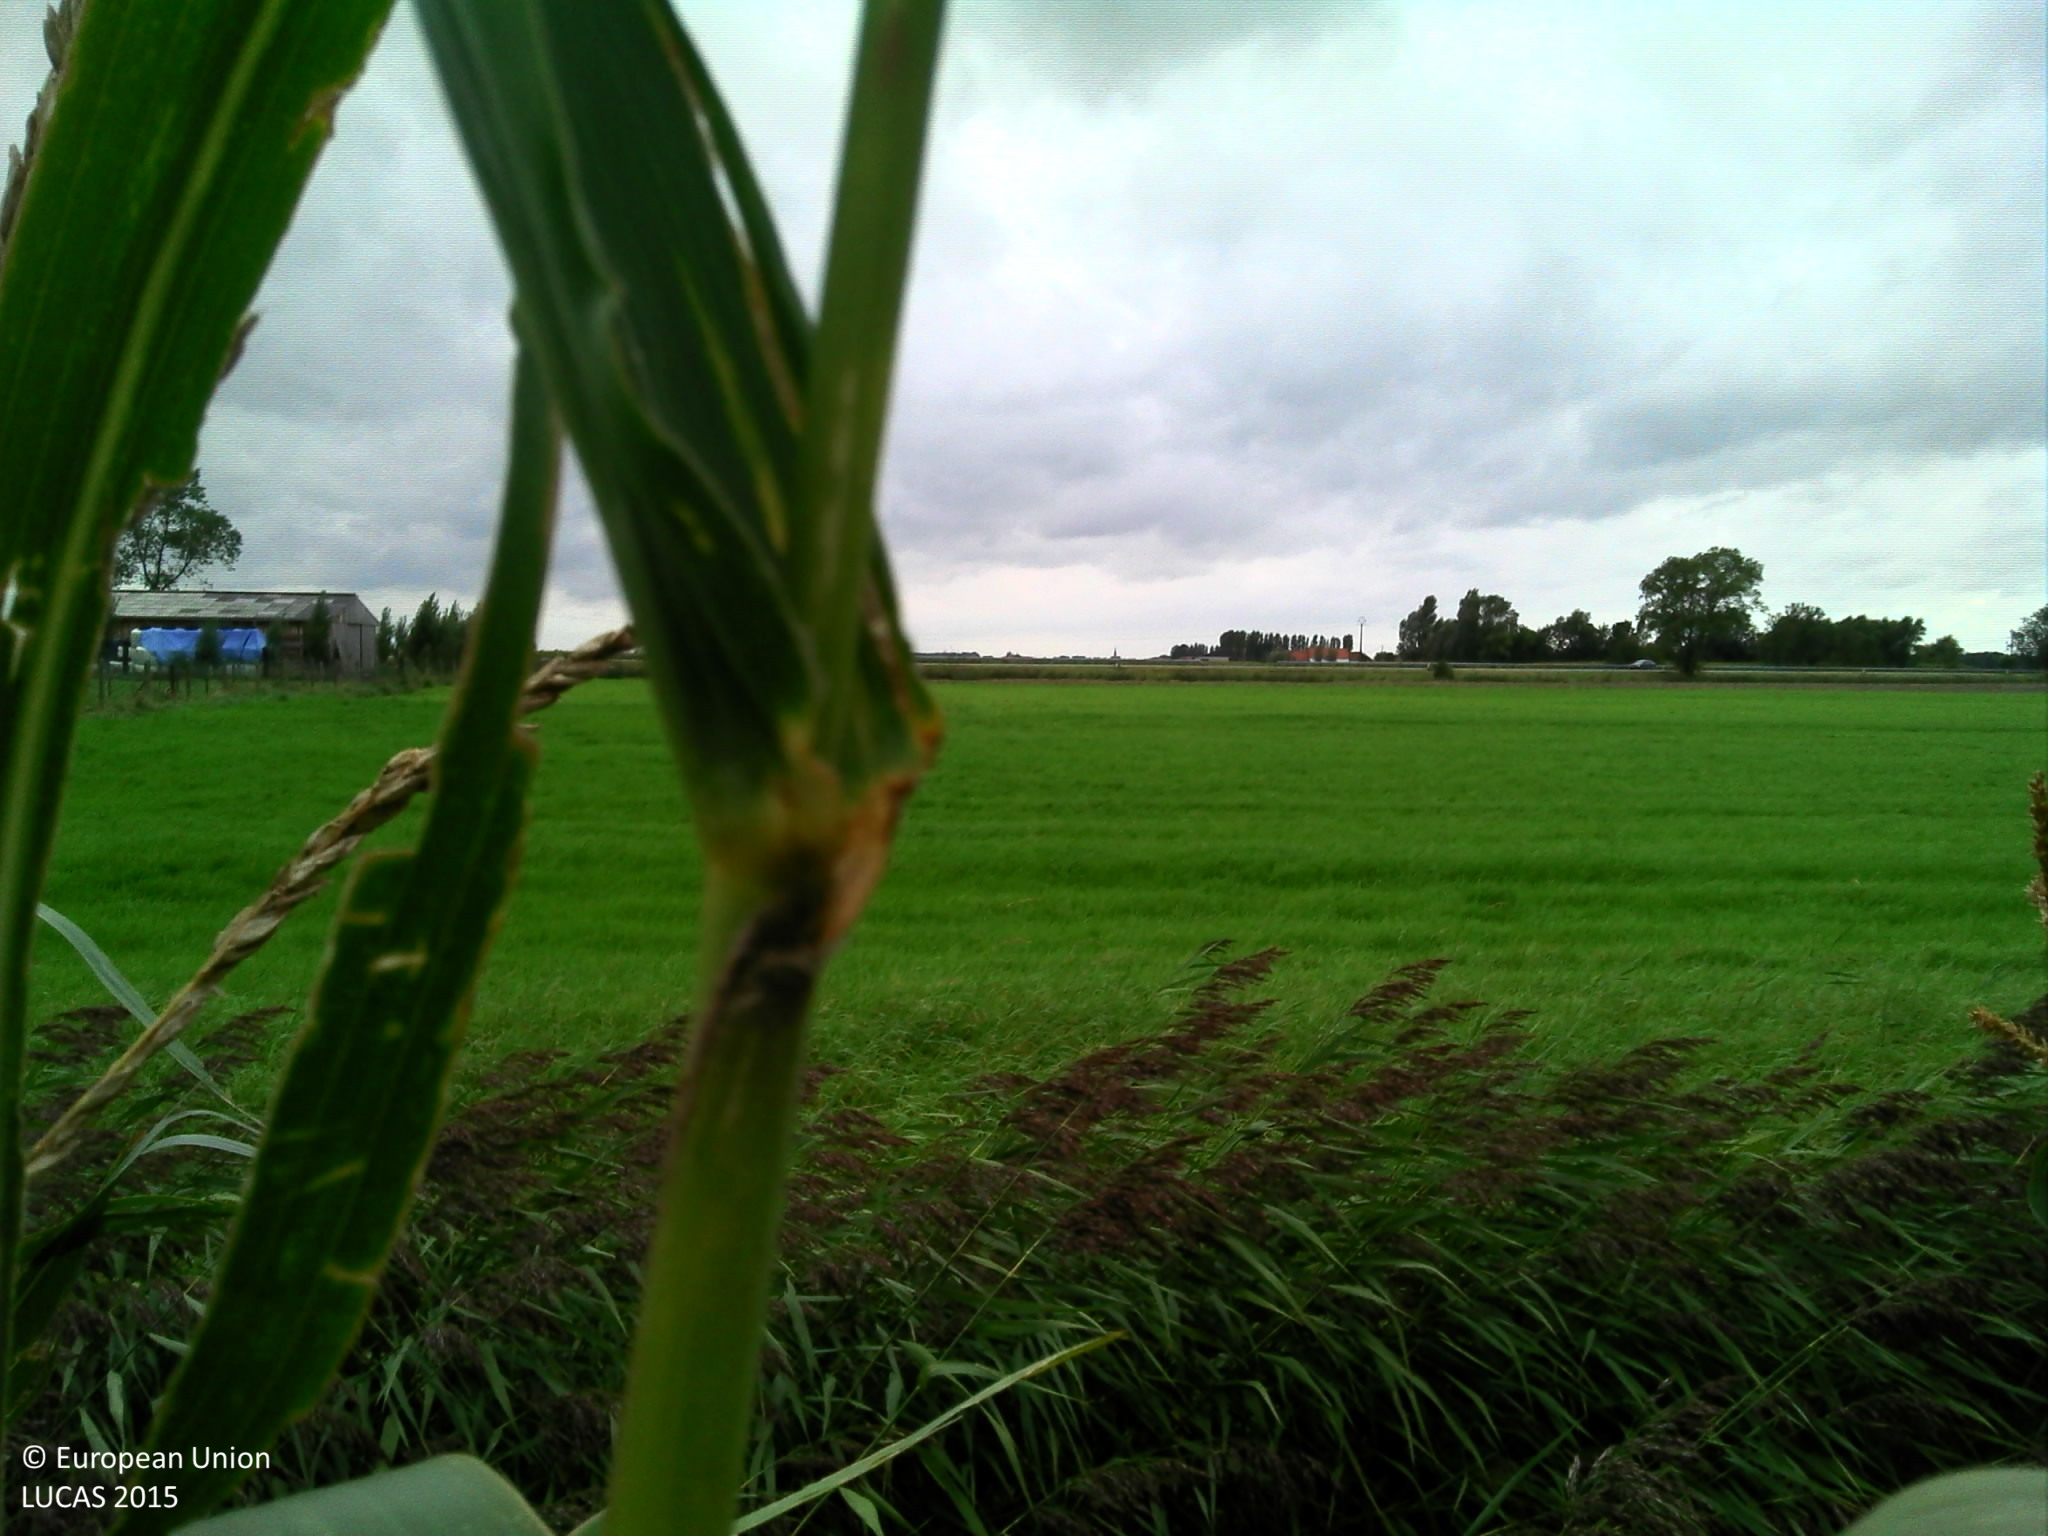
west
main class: Cropland
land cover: Maize
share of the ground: > 75 %
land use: Agriculture (excluding fallow land and kitchen gardens)
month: September
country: BE
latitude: 51.1405
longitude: 2.9719
